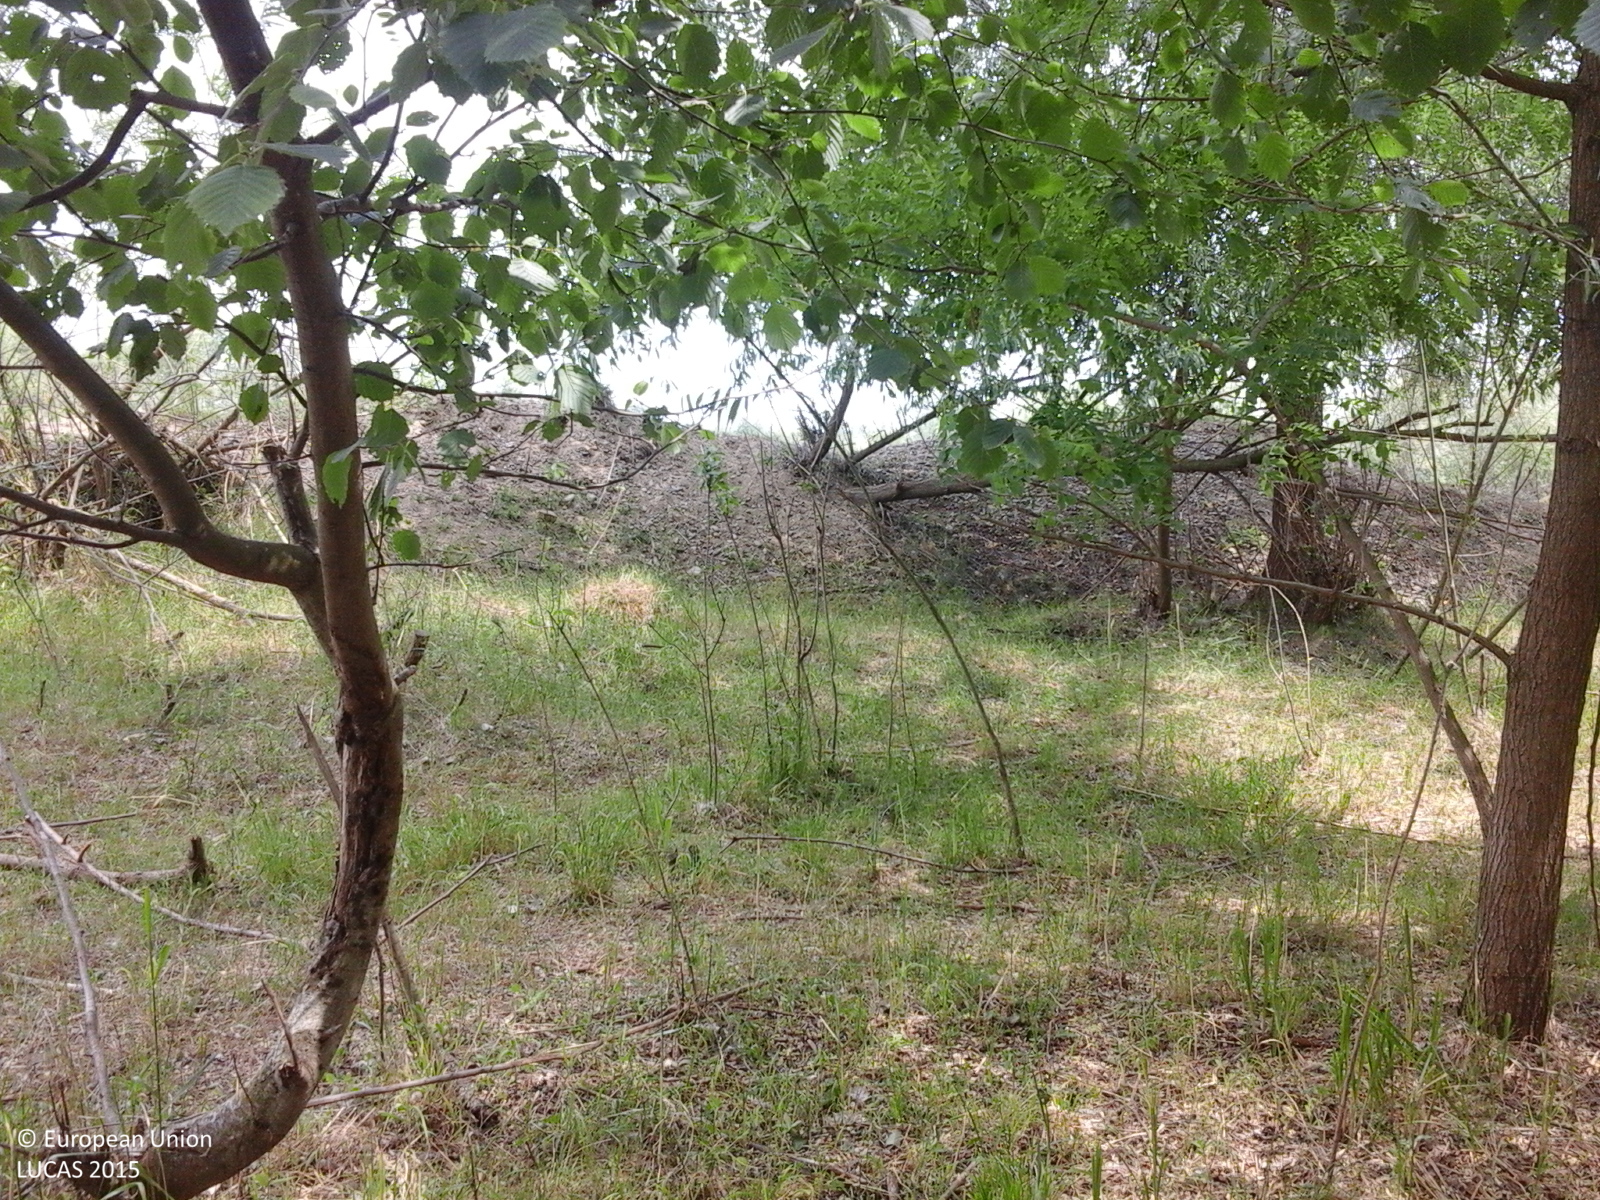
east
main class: Woodland
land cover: Broadleaved woodland
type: floodplain forest
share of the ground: > 75 %
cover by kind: broadleaved forest trees 85 %, shrubs 10 %, herbaceous plants 5 %
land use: Semi-natural and natural areas not in use
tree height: < 5 m
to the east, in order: Broadleaved woodland; Grassland with sparse tree/shrub cover; Tracks; Grassland with sparse tree/shrub cover; Tracks; Rocks and stones; Tracks; Rocks and stones; Broadleaved woodland; Tracks; Broadleaved woodland
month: June
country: RO
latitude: 47.0413
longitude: 26.7415
